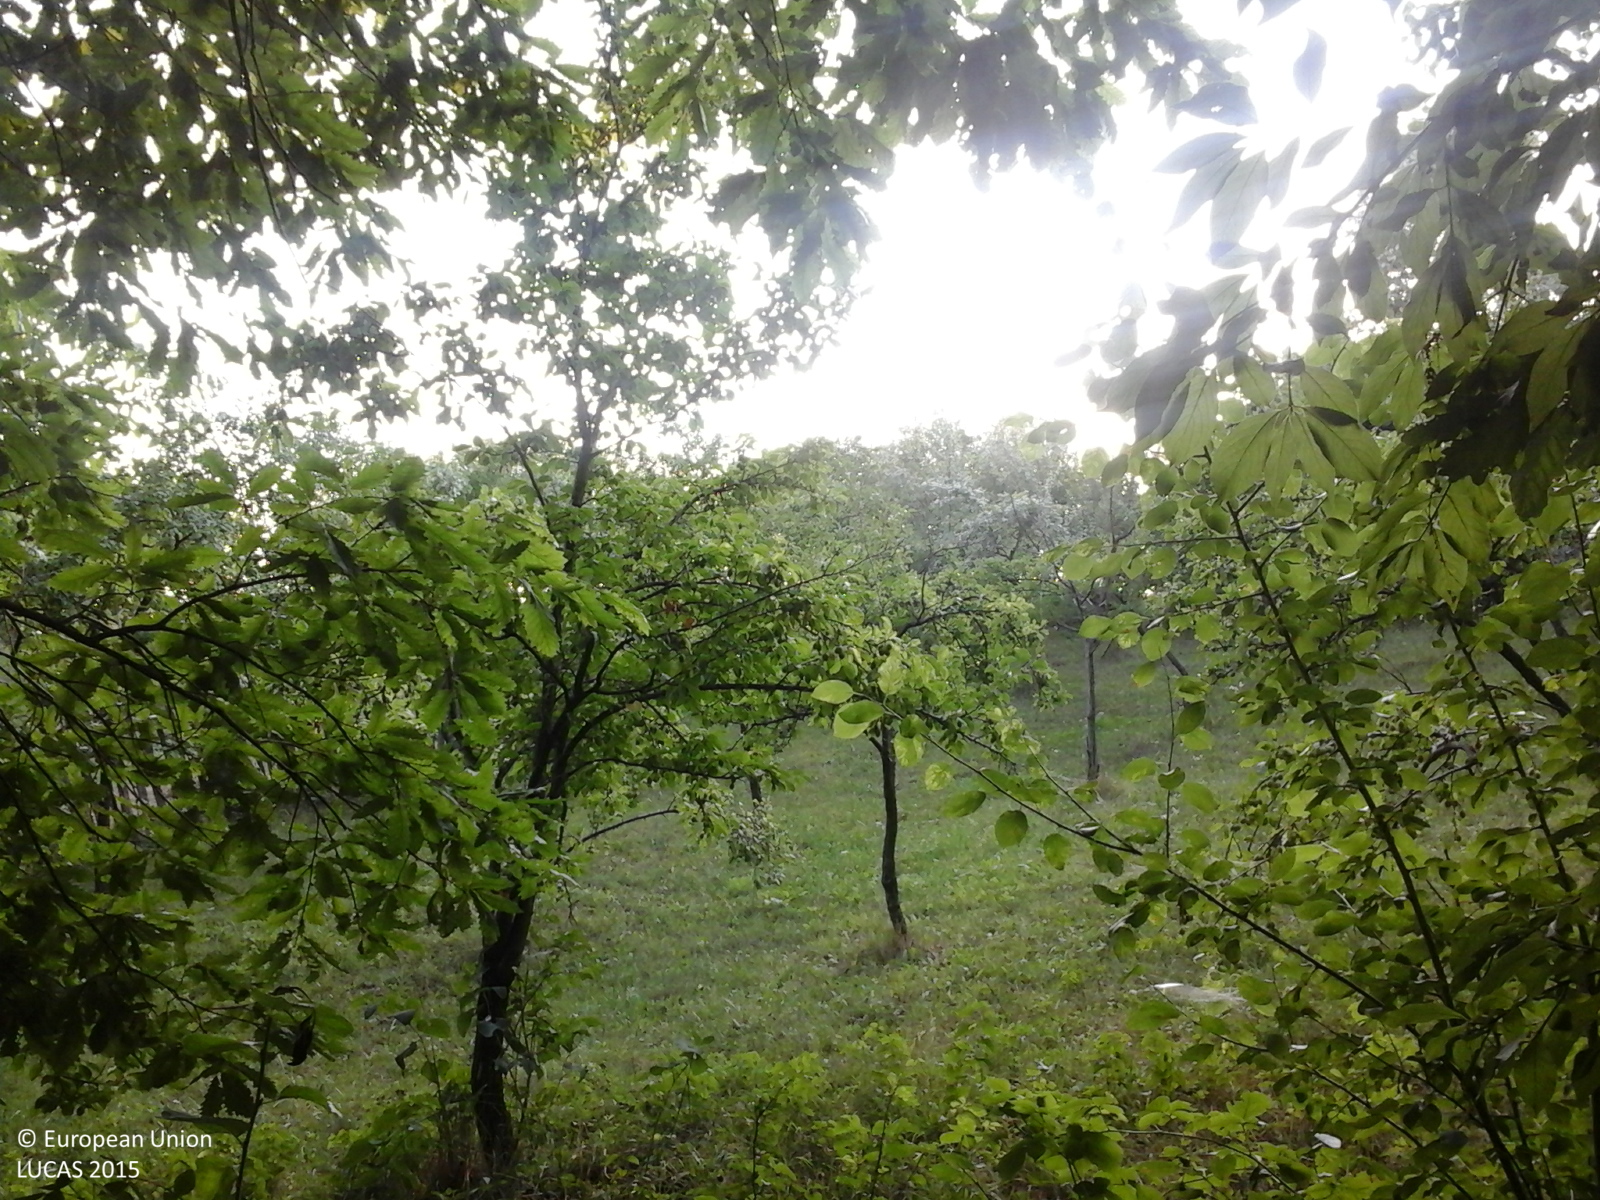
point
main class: Cropland
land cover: Other fruit trees and berries
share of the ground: 50 - 75 %
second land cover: Grassland without tree/shrub cover
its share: > 75 %
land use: Agriculture (excluding fallow land and kitchen gardens)
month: July
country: RO
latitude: 44.8785
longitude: 24.5188
